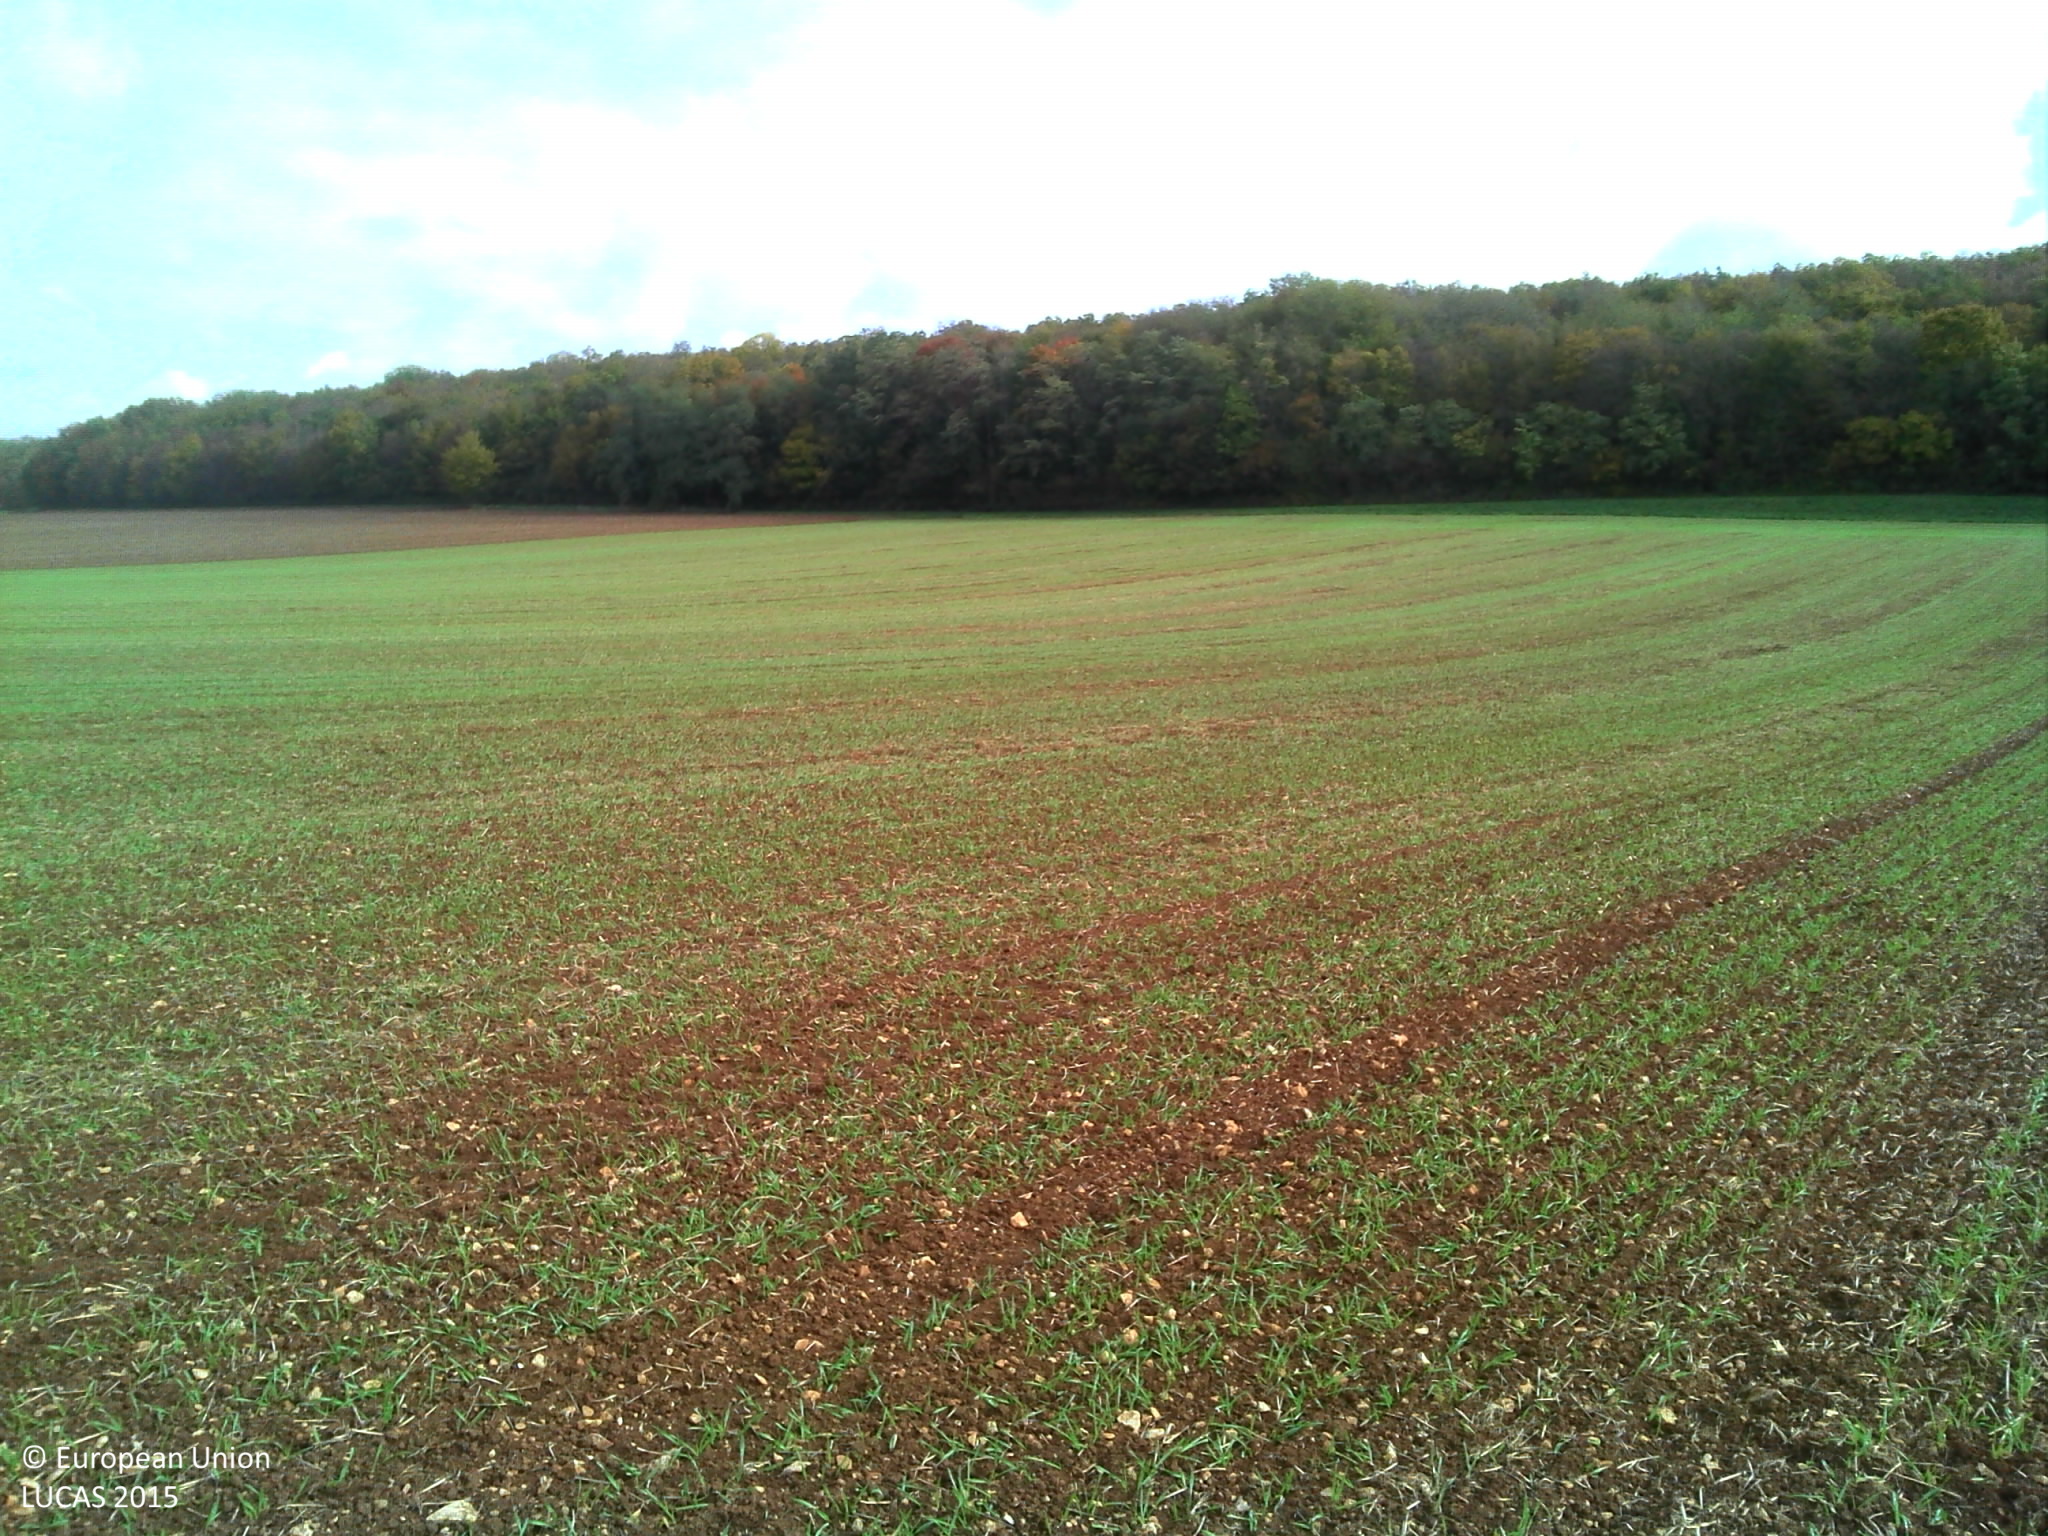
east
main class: Cropland
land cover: Common wheat
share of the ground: 25 - 50 %
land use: Agriculture (excluding fallow land and kitchen gardens)
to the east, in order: Common wheat; Grass margins; Tracks; Grass margins; Broadleaved woodland
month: October
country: FR
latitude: 47.3842
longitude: 4.9003
